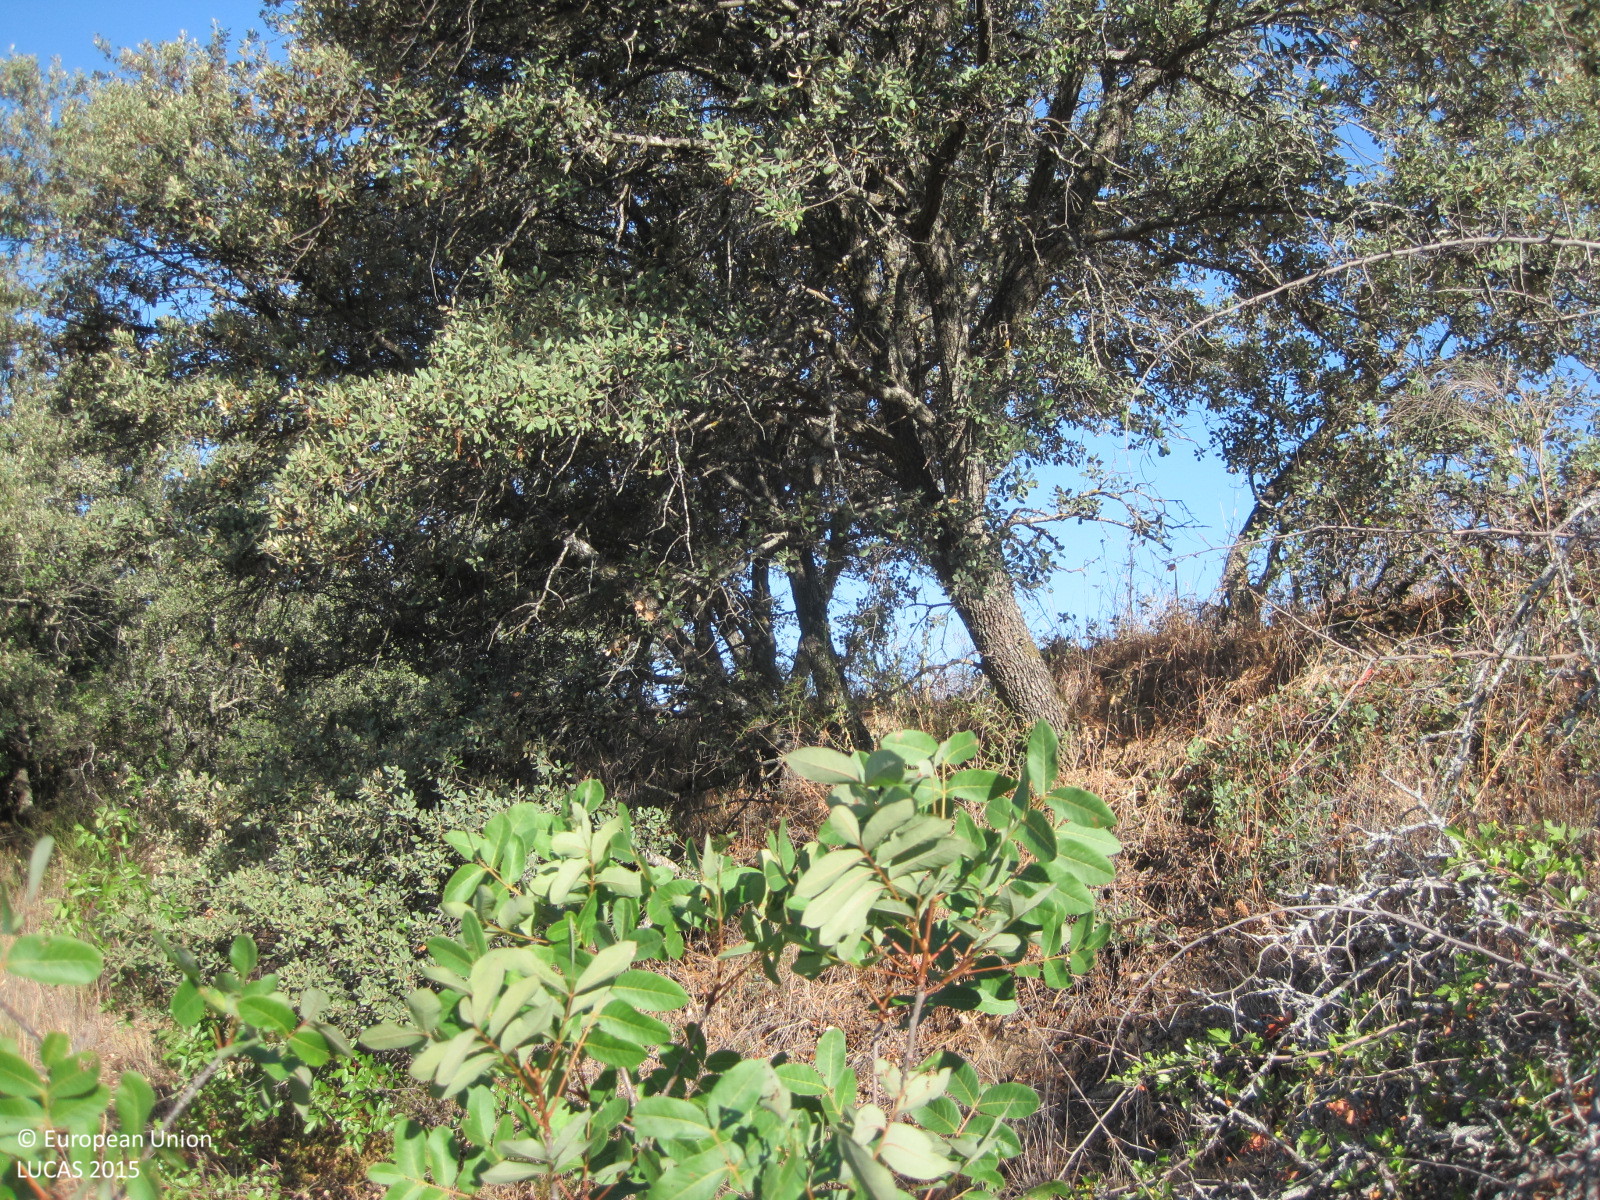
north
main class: Shrubland
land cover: Shrubland with sparse tree cover
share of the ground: > 75 %
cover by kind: shrubs 95 %, coniferous forest trees 5 %
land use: Semi-natural and natural areas not in use
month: July
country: ES
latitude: 40.2624
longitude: -4.4024
